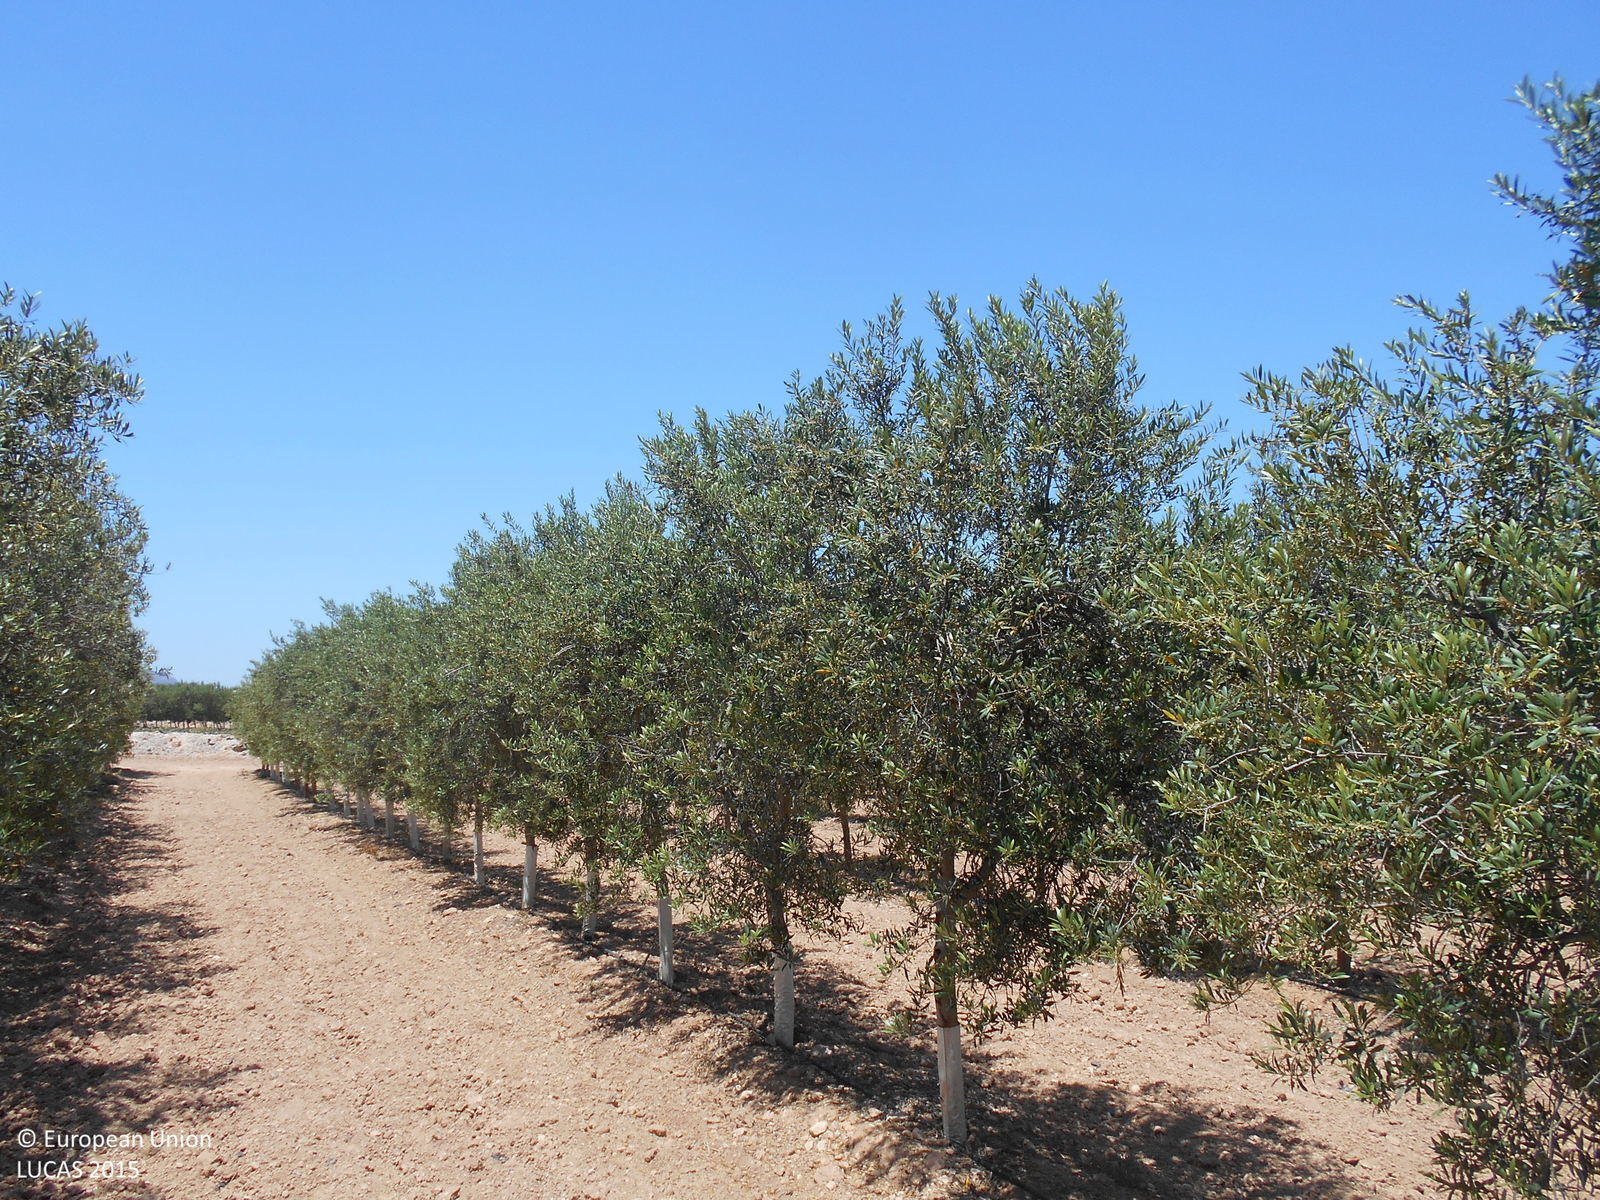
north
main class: Cropland
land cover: Olive groves
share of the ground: 25 - 50 %
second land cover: Other bare soil
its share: > 75 %
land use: Agriculture (excluding fallow land and kitchen gardens)
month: June
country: ES
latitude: 37.8475
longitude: -0.9252
